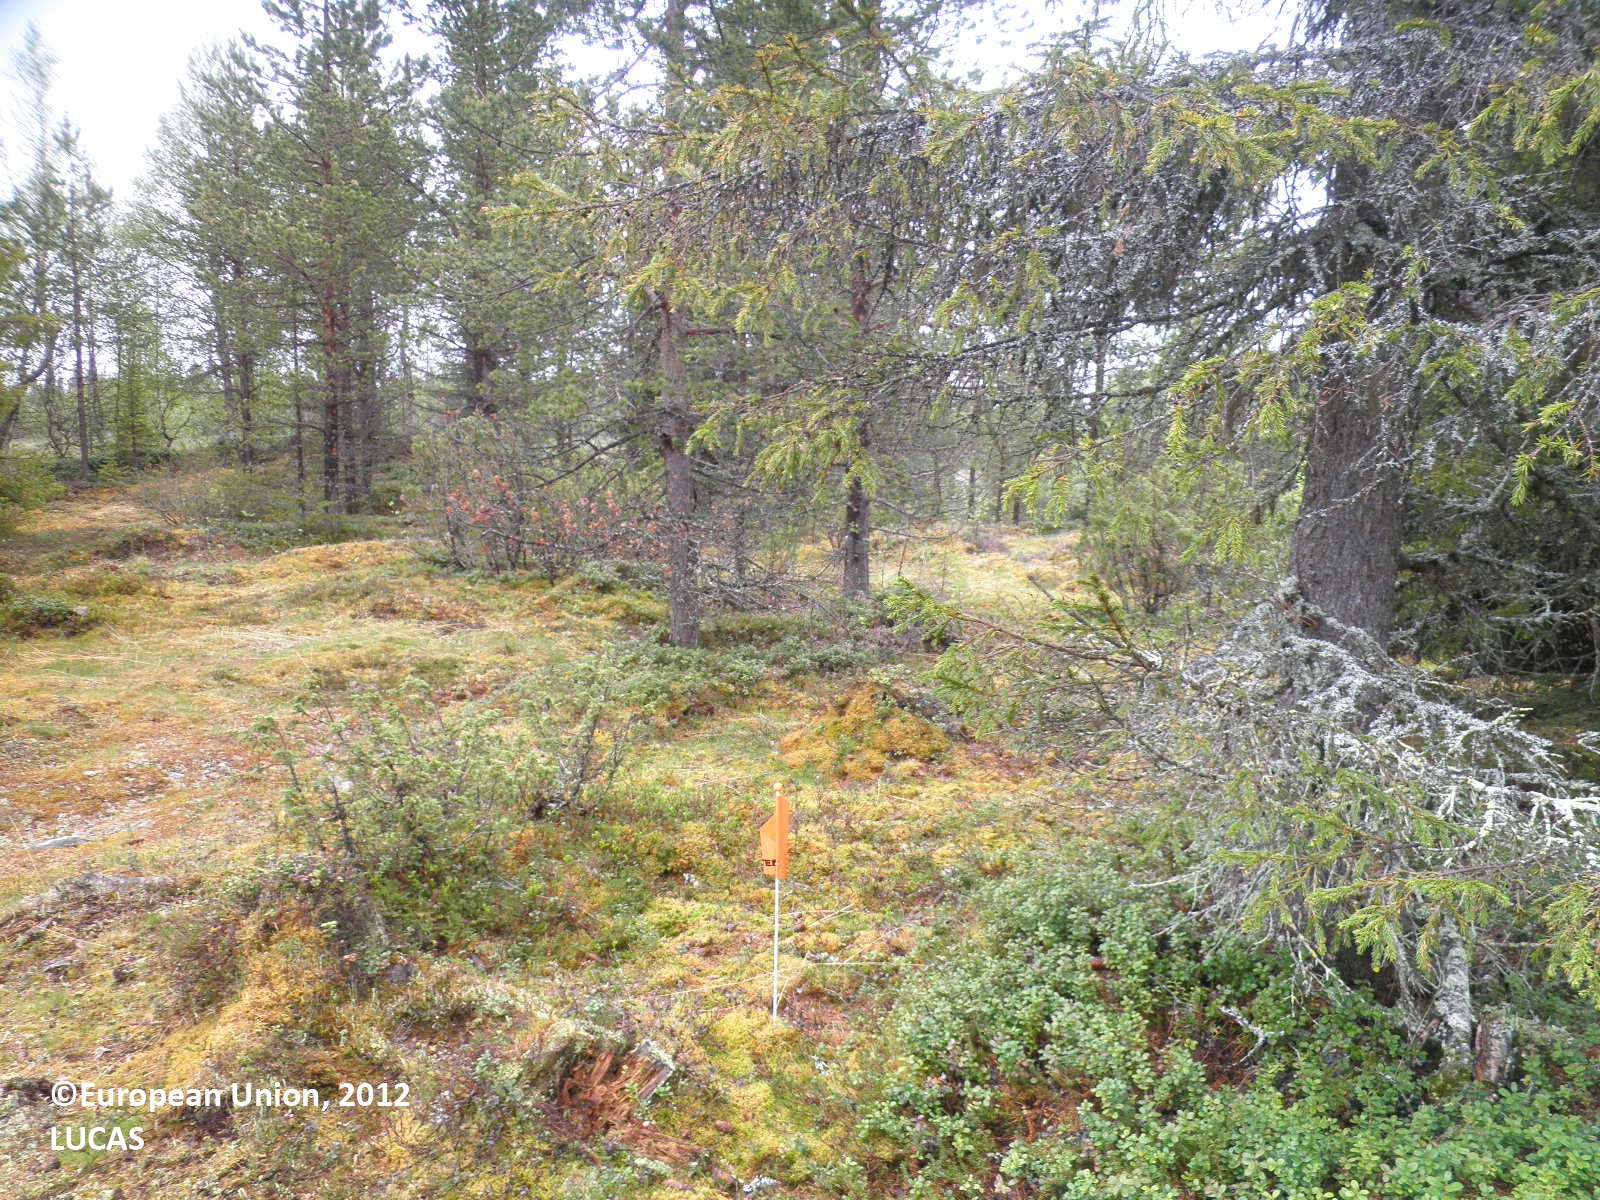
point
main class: Woodland
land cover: Other coniferous woodland
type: boreal forest
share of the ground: 25 - 50 %
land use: Forestry
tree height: > 5 m
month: June
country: FI
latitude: 68.1028
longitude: 25.6362
